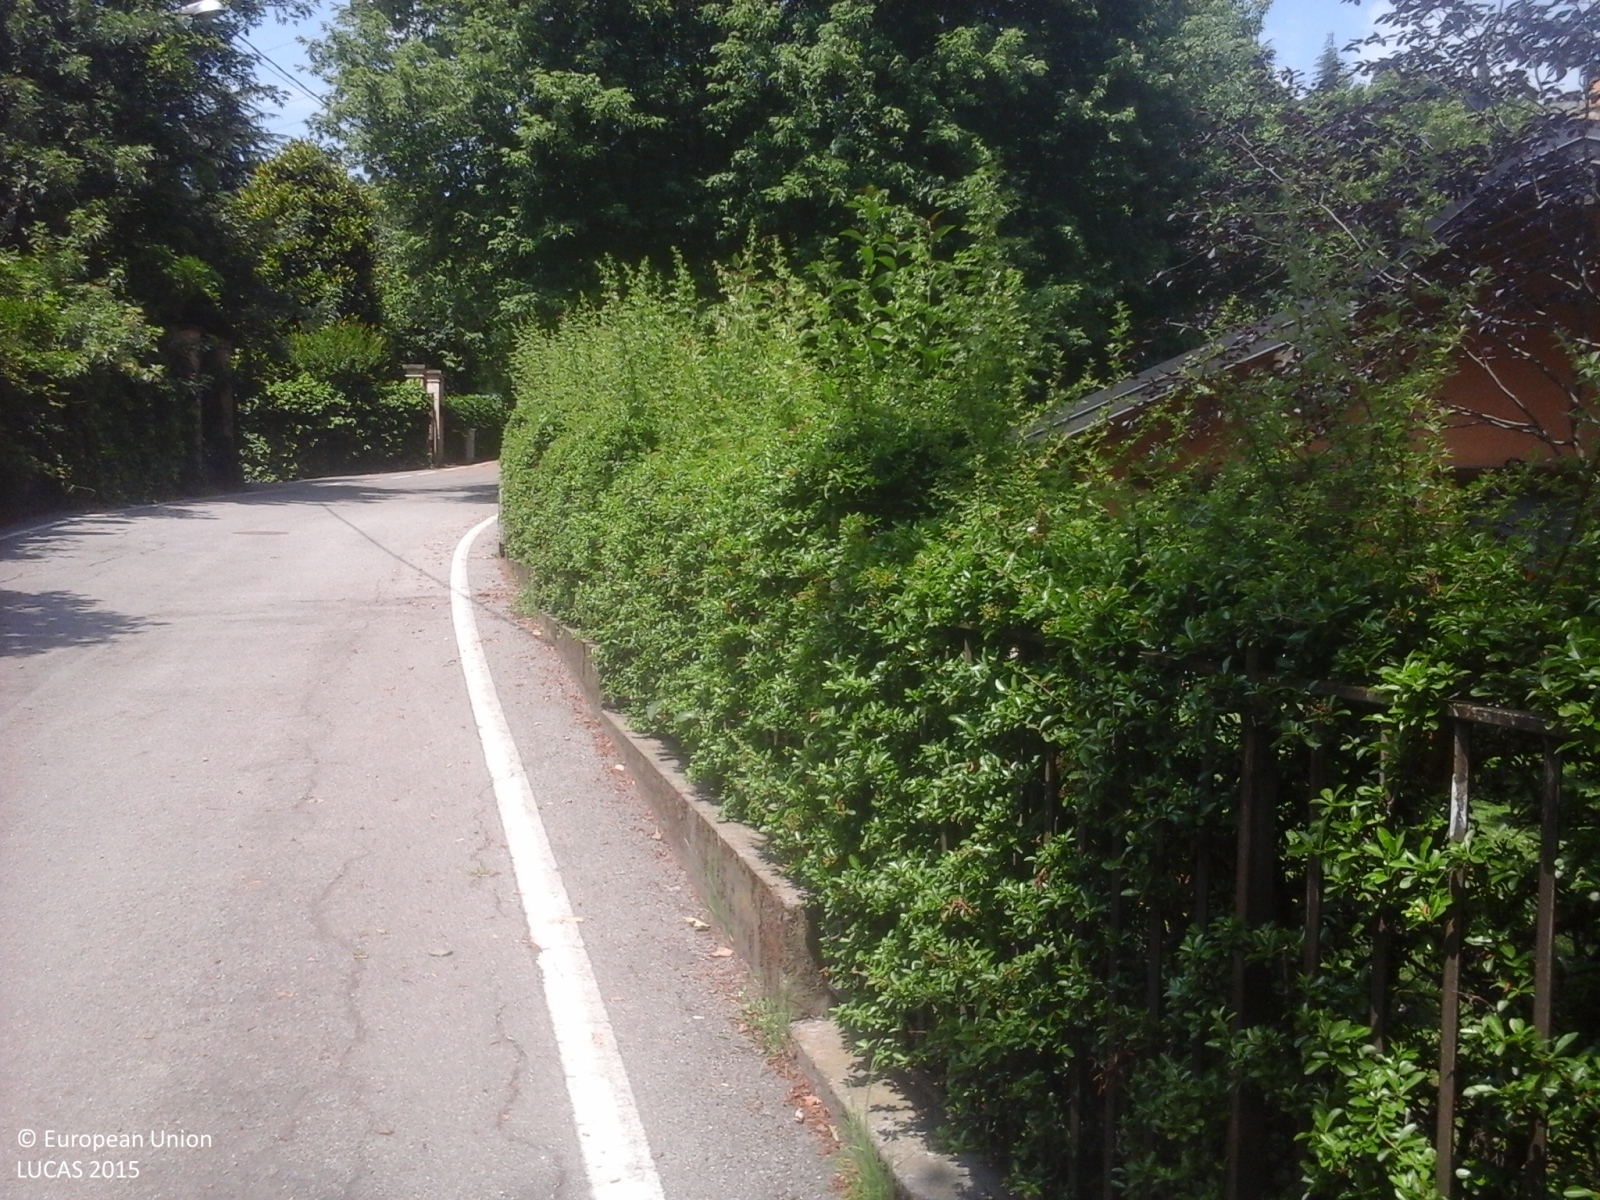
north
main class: Woodland
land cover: Broadleaved woodland
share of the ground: > 75 %
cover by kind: broadleaved forest trees 85 %, shrubs 10 %, herbaceous plants 5 %
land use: Residential
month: June
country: IT
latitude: 45.7008
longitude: 9.3717
